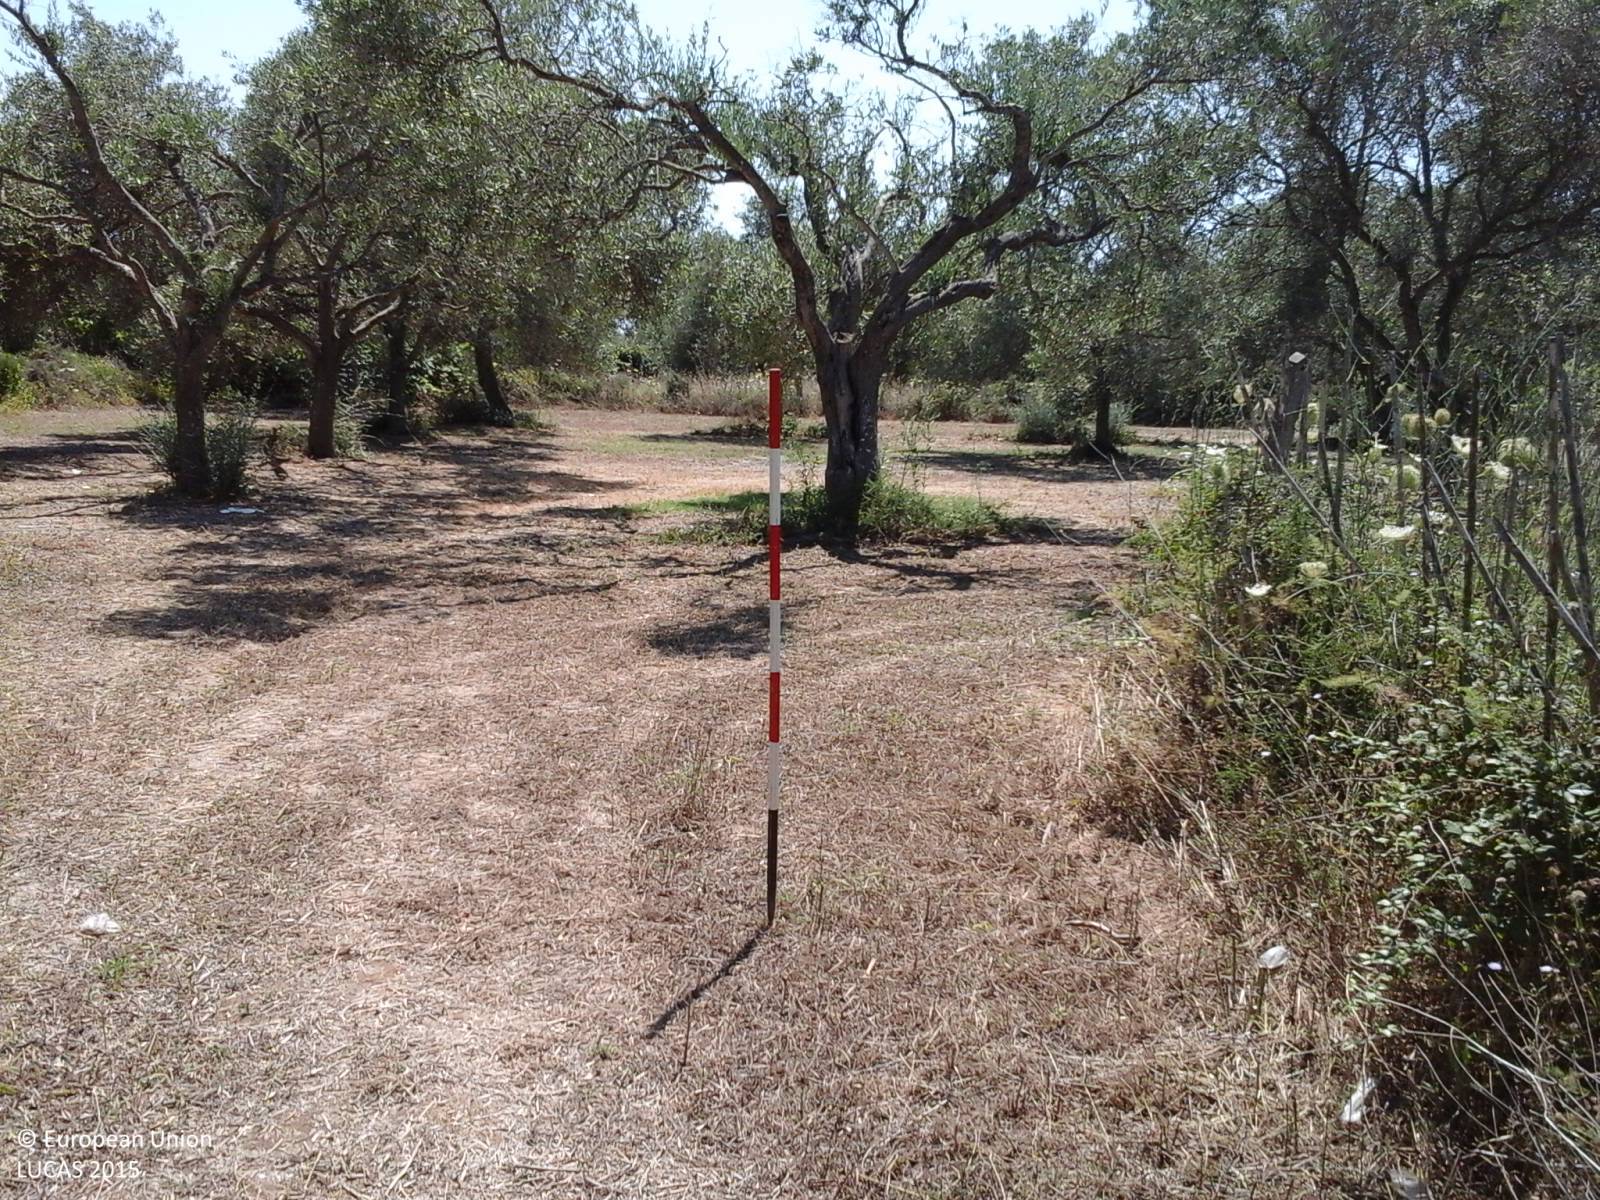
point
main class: Cropland
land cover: Olive groves
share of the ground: > 75 %
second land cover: Grassland without tree/shrub cover
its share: > 75 %
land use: Agriculture (excluding fallow land and kitchen gardens)
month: July
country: IT
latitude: 39.9665
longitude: 8.5212
